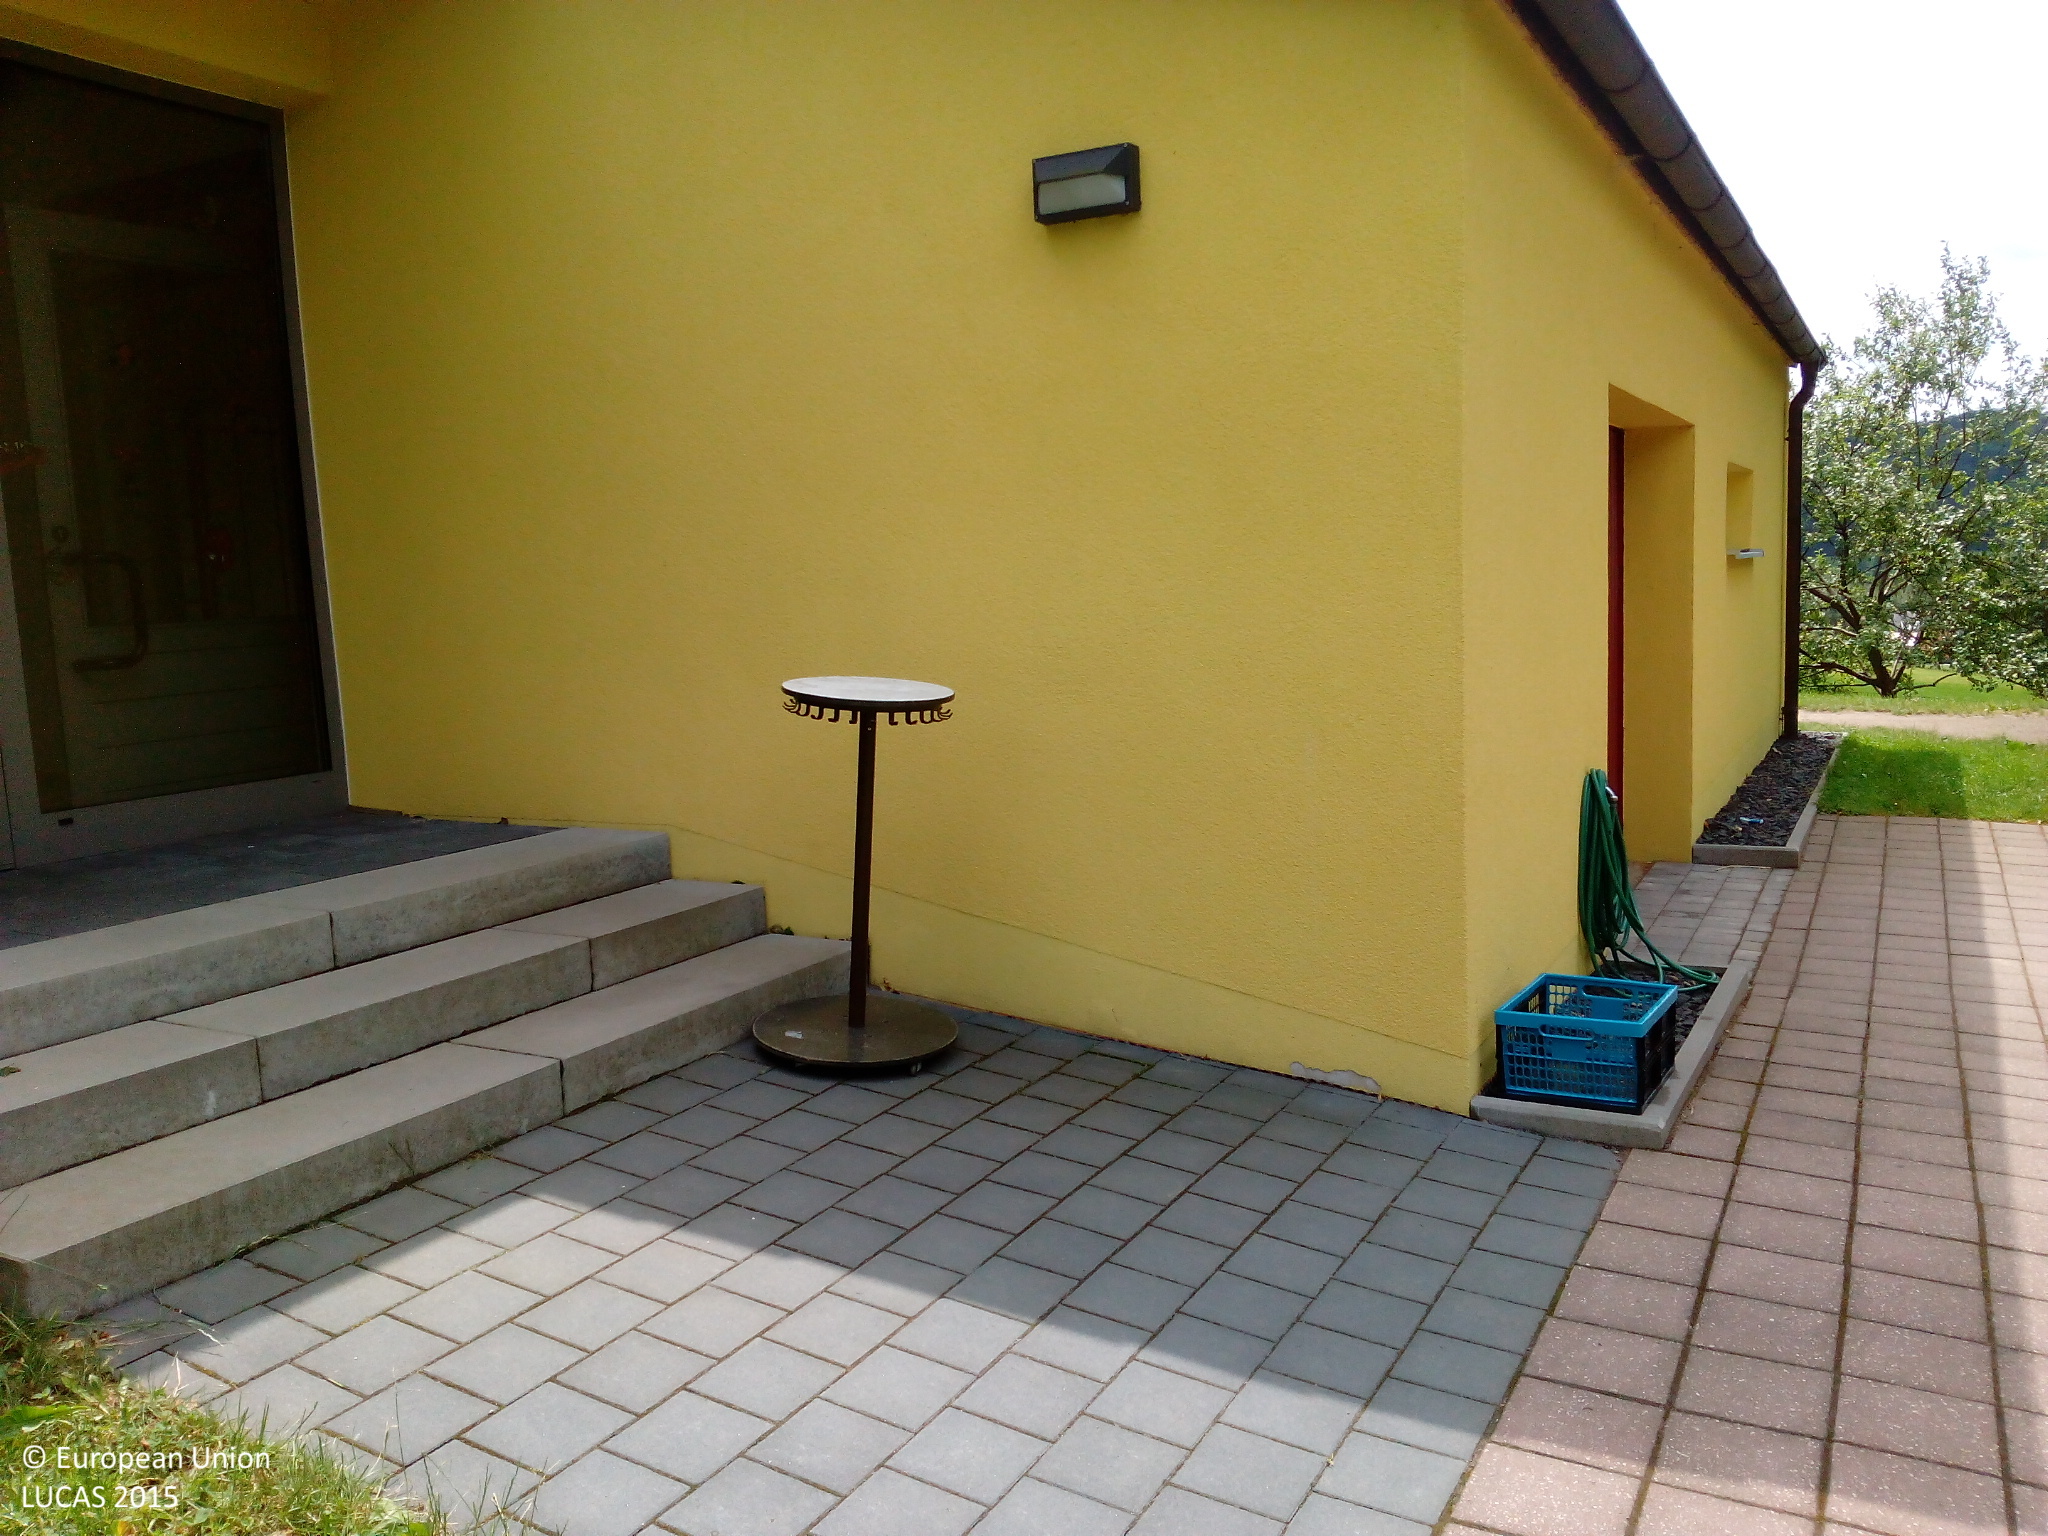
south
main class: Grassland
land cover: Grassland without tree/shrub cover
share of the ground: > 75 %
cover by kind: herbaceous plants 100 %
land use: Community services
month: July
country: DE
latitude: 49.7087
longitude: 12.4264
